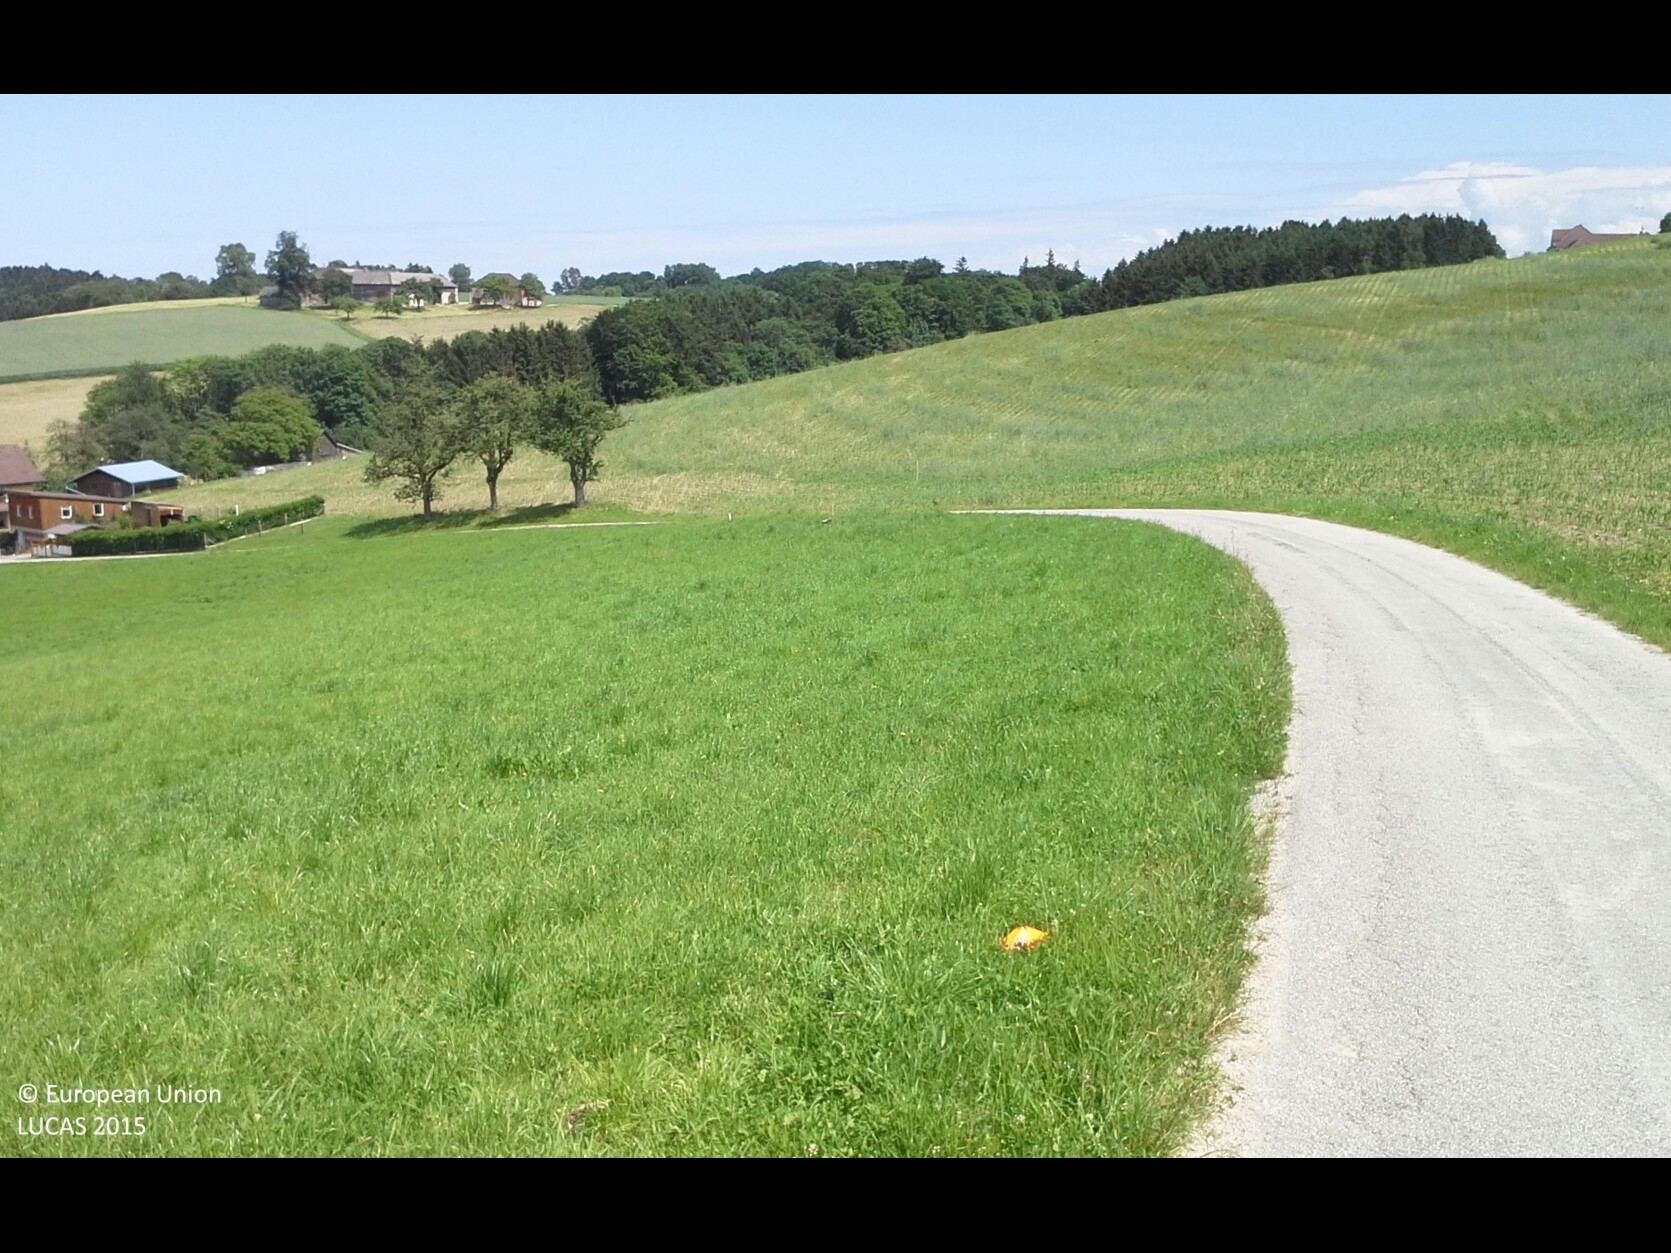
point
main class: Grassland
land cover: Grassland without tree/shrub cover
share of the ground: > 75 %
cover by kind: herbaceous plants 100 %
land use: Agriculture (excluding fallow land and kitchen gardens)
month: June
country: AT
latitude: 48.1360
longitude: 14.8249
